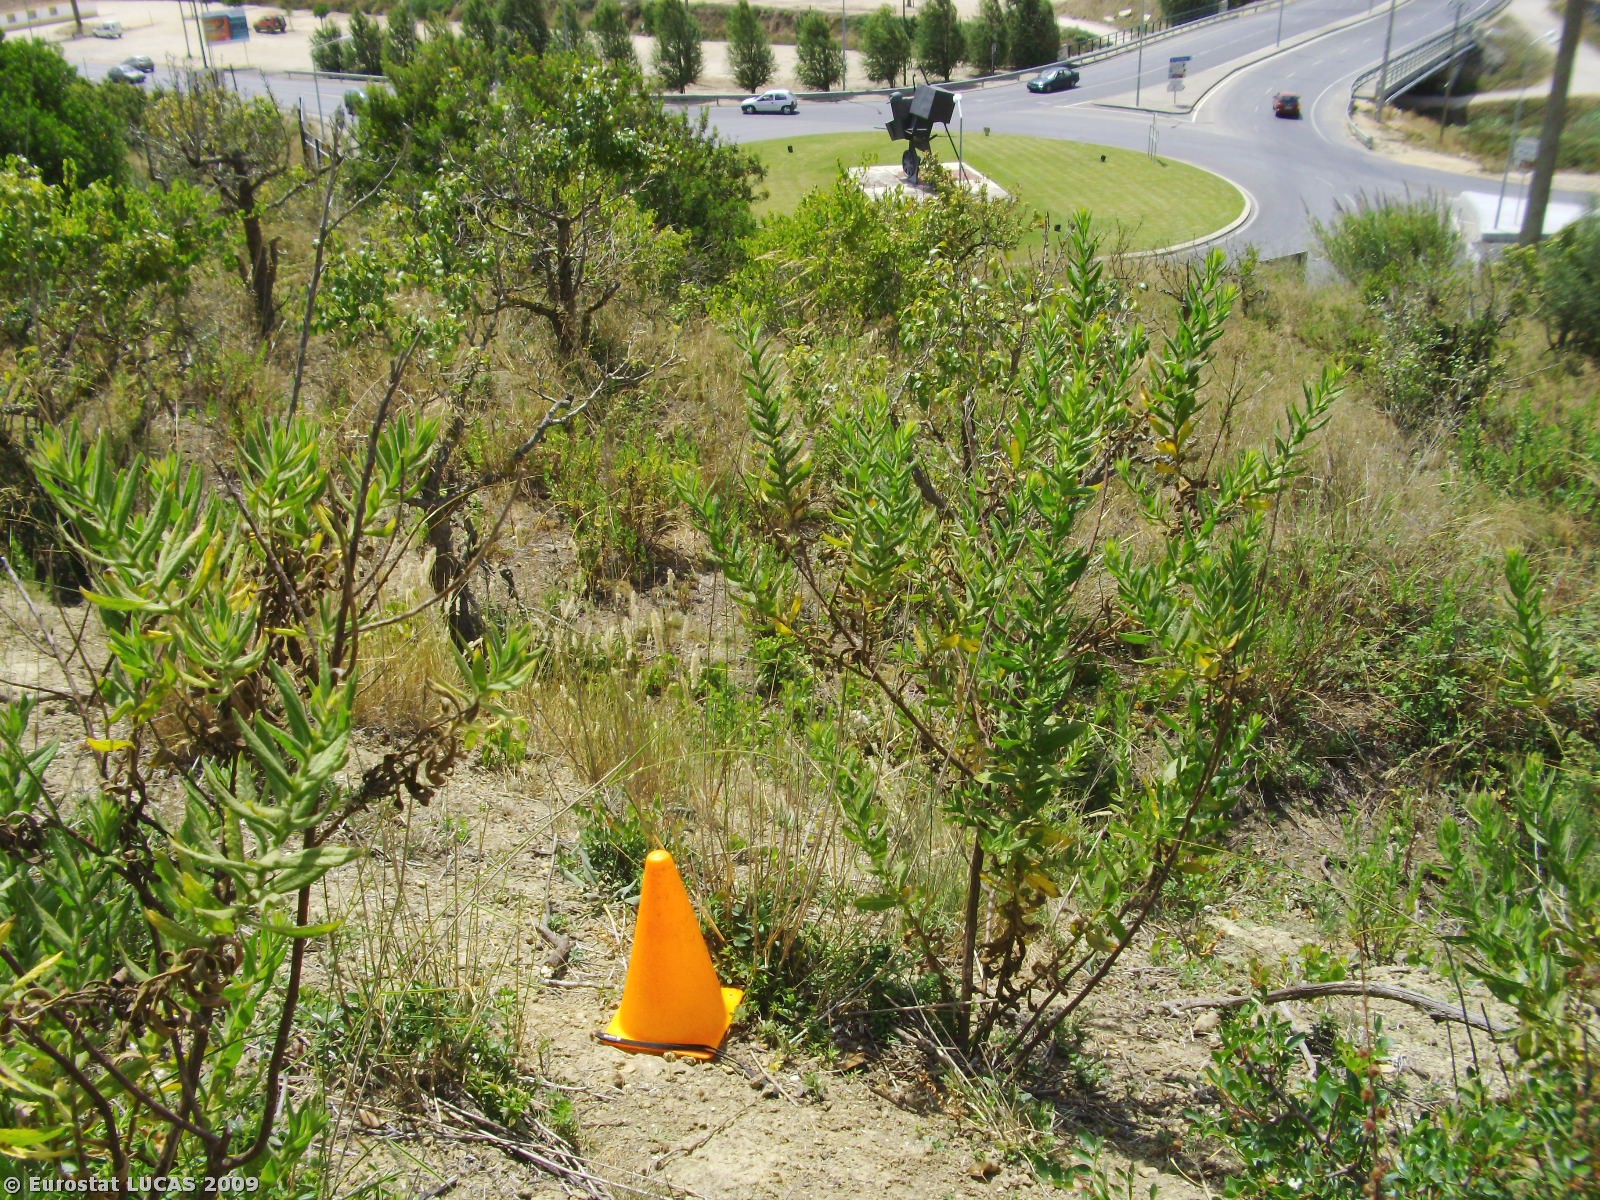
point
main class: Shrubland
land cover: Shrubland with sparse tree cover
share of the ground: 50 - 75 %
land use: Unused
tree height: < 5 m
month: July
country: PT
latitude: 39.0968
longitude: -9.2688
